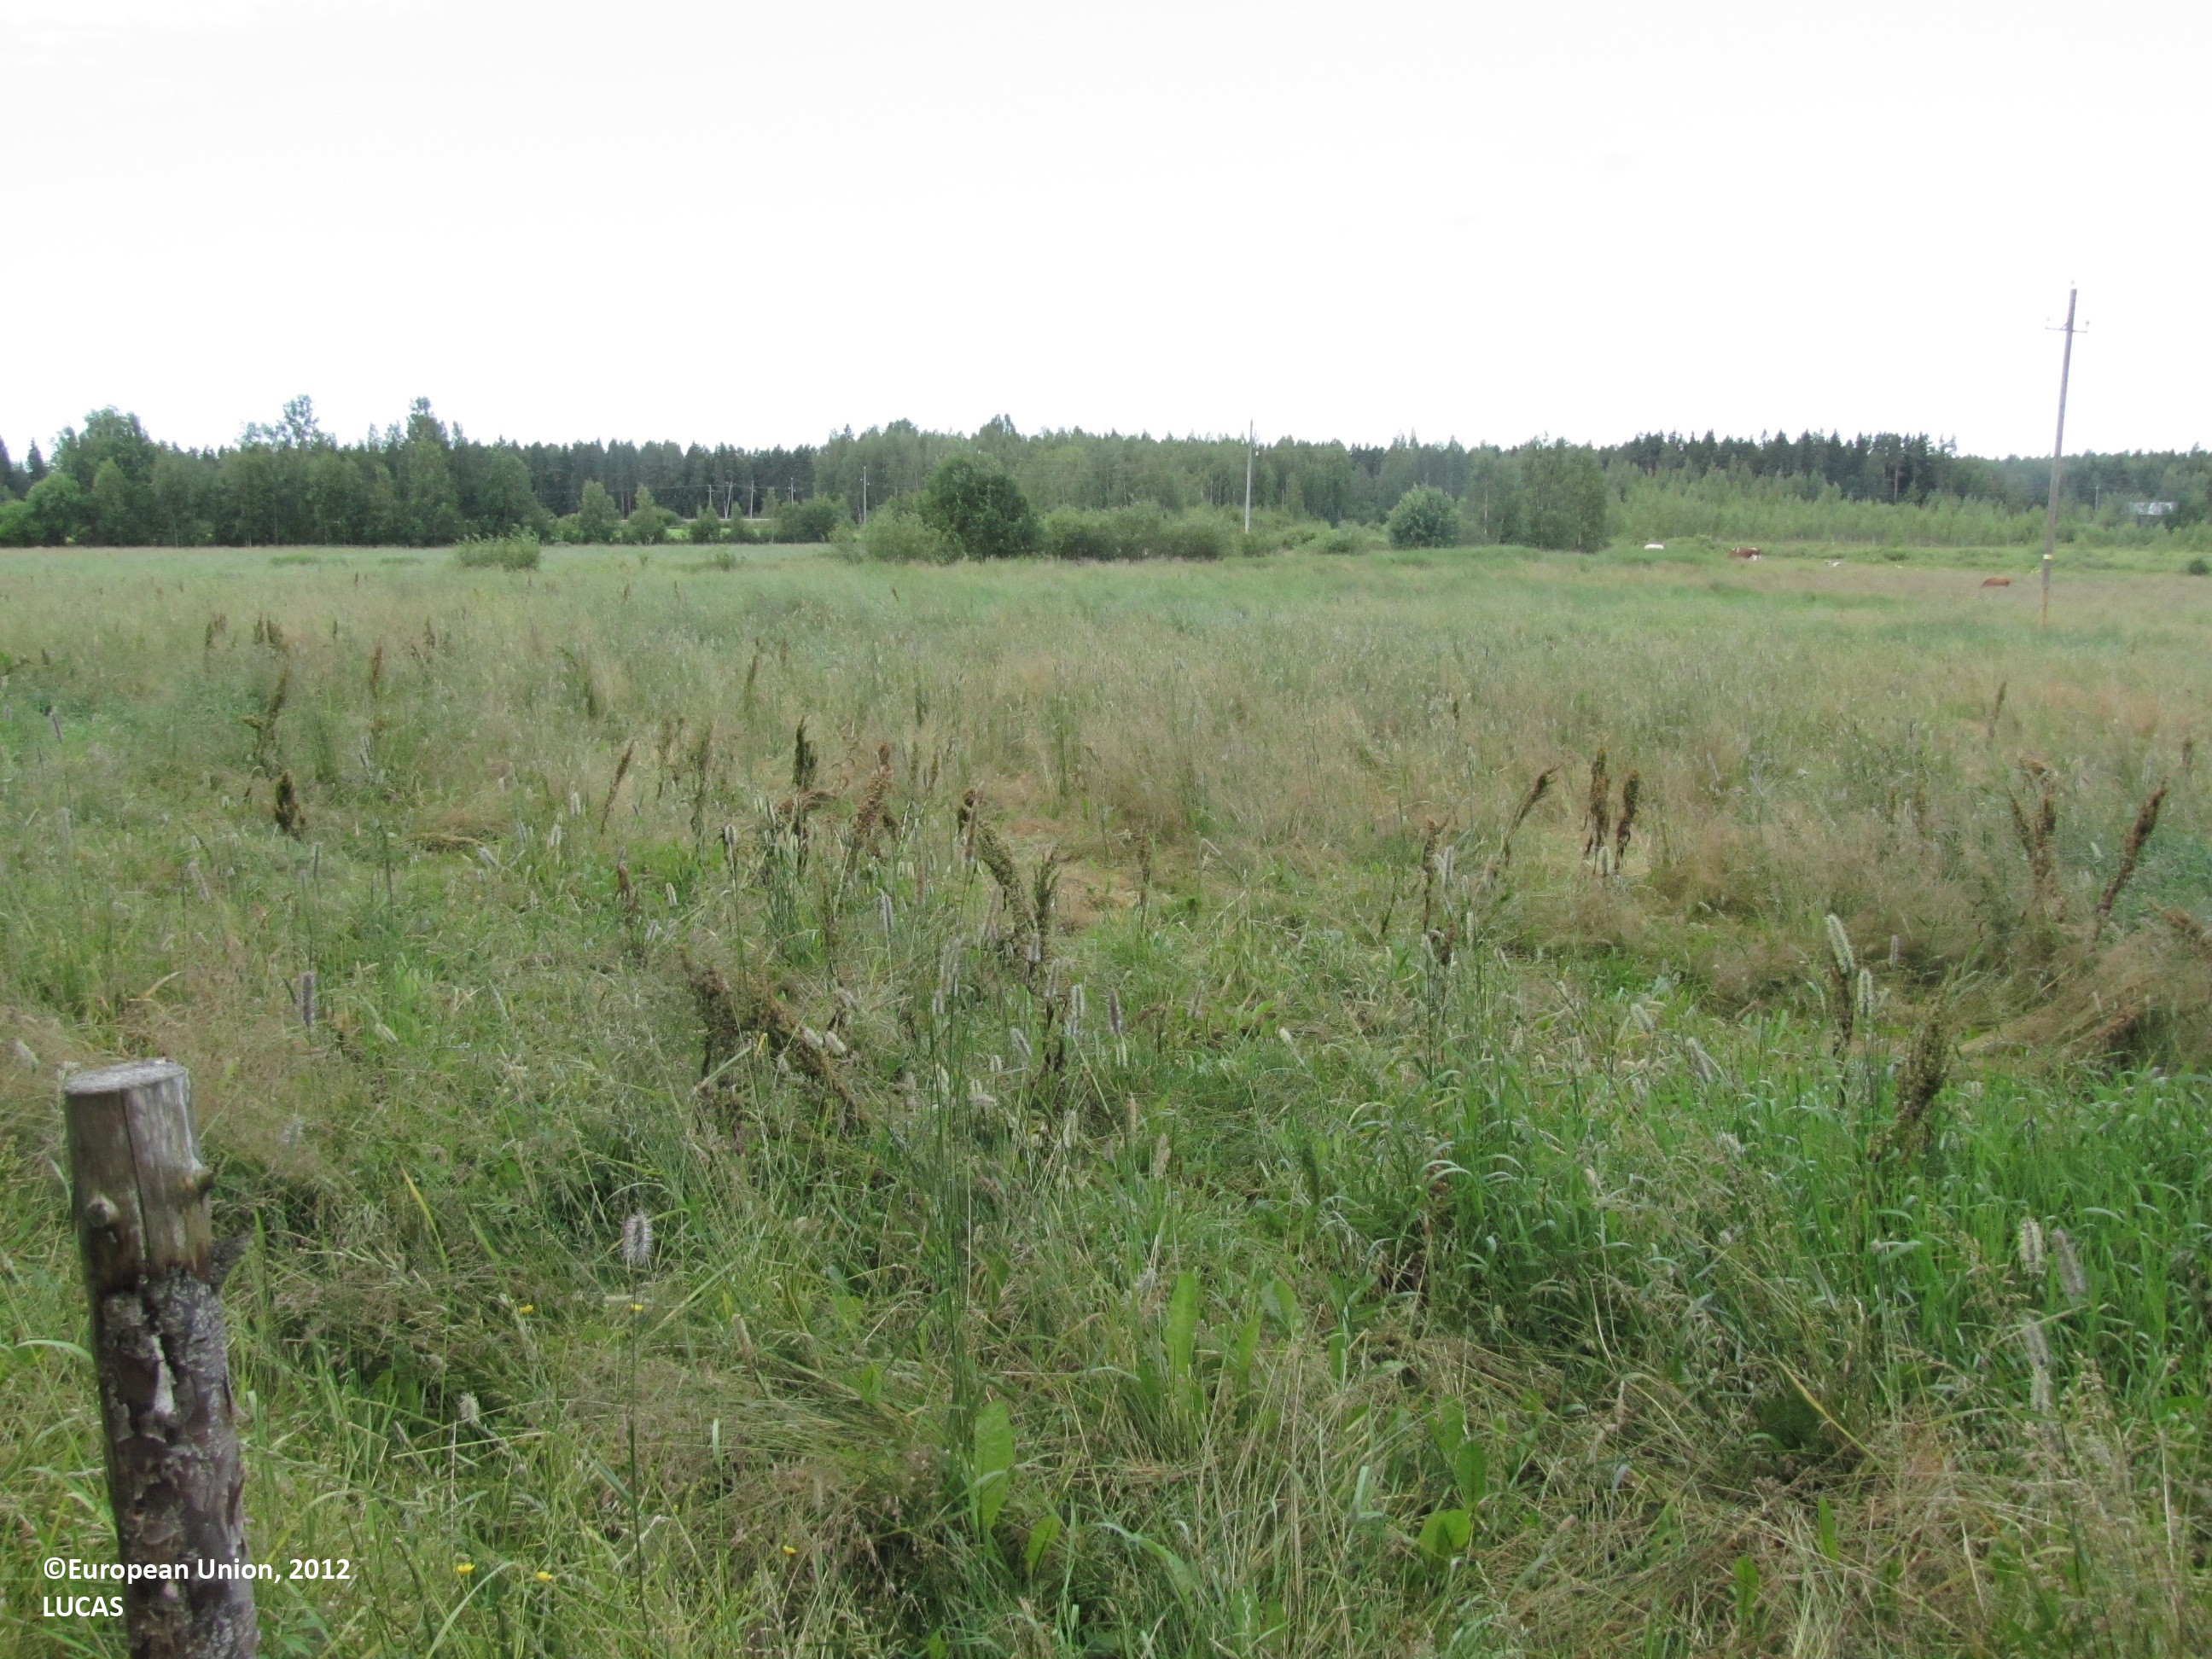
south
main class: Grassland
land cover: Grassland without tree/shrub cover
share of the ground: > 75 %
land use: Agriculture (excluding fallow land and kitchen gardens)
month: July
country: FI
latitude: 62.6204
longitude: 23.3409
